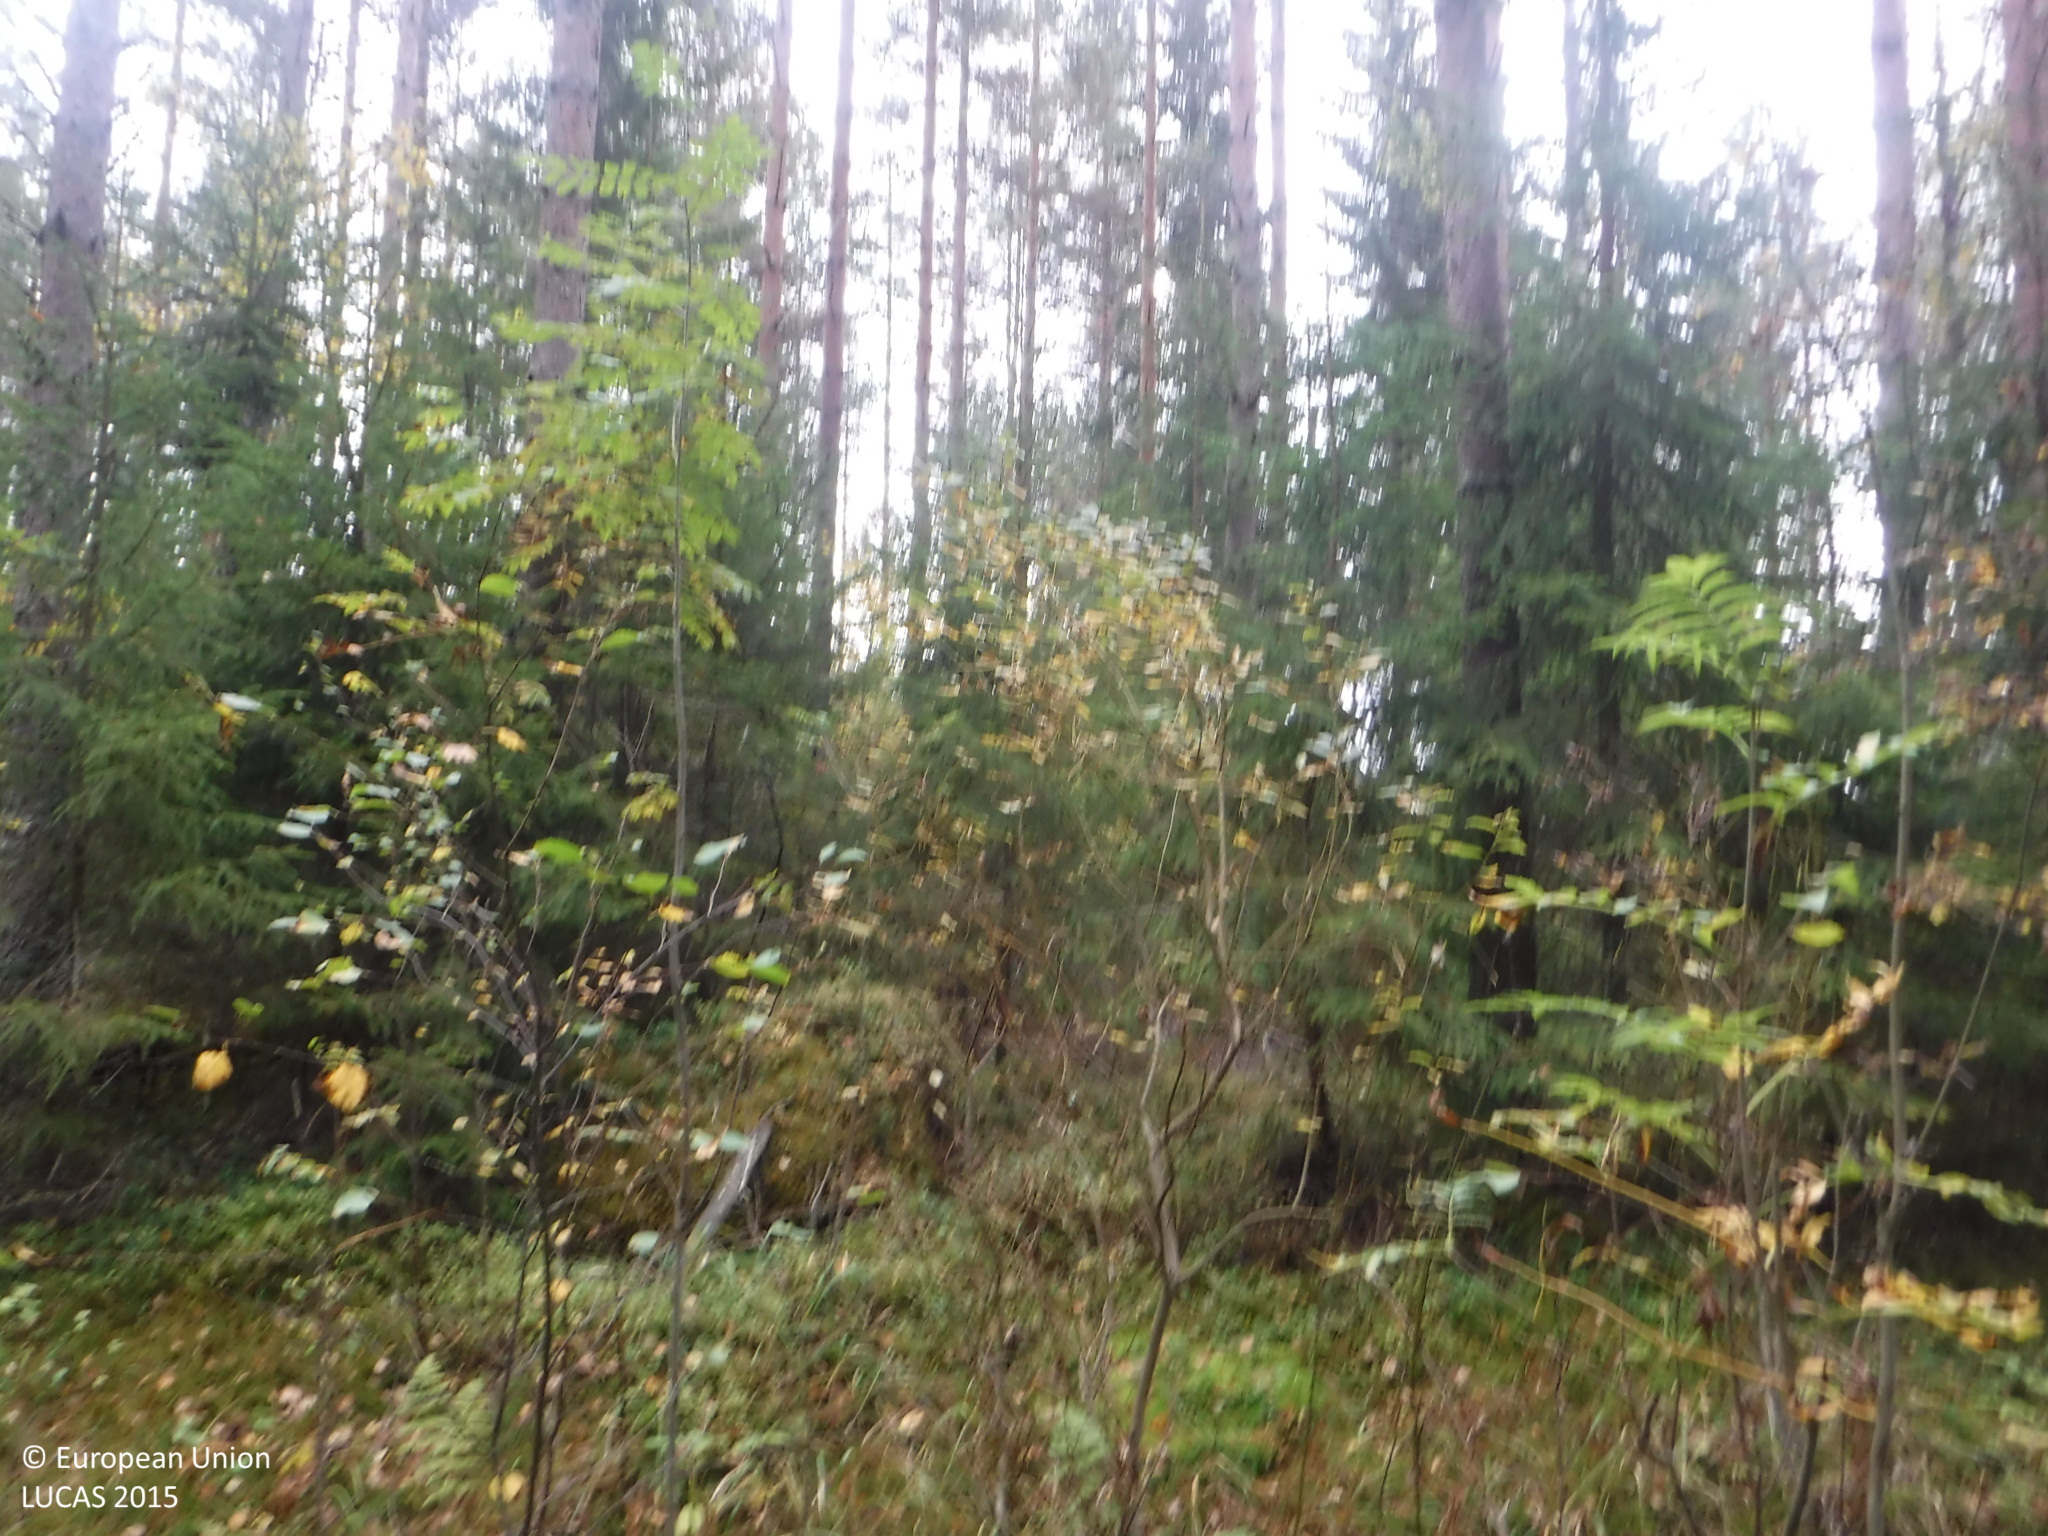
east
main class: Woodland
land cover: Other coniferous woodland
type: boreal forest
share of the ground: 50 - 75 %
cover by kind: coniferous forest trees 55 %, lichens and mosses 20 %, shrubs 15 %, broadleaved forest trees 10 %
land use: Forestry
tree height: > 5 m
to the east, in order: Other coniferous woodland; Spontaneously vegetated surfaces; Ditches and canals; Tracks; Ditches and canals; Shruby margins; Spruce dominated coniferous woodland; Ditches and canals; Spruce dominated coniferous woodland; Ditches and canals; Spruce dominated coniferous woodland; Other mixed woodland; Spruce dominated coniferous woodland; Ditches and canals; Spruce dominated coniferous woodland; Ditches and canals; Spruce dominated coniferous woodland
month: September
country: FI
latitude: 61.7756
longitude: 24.1342
